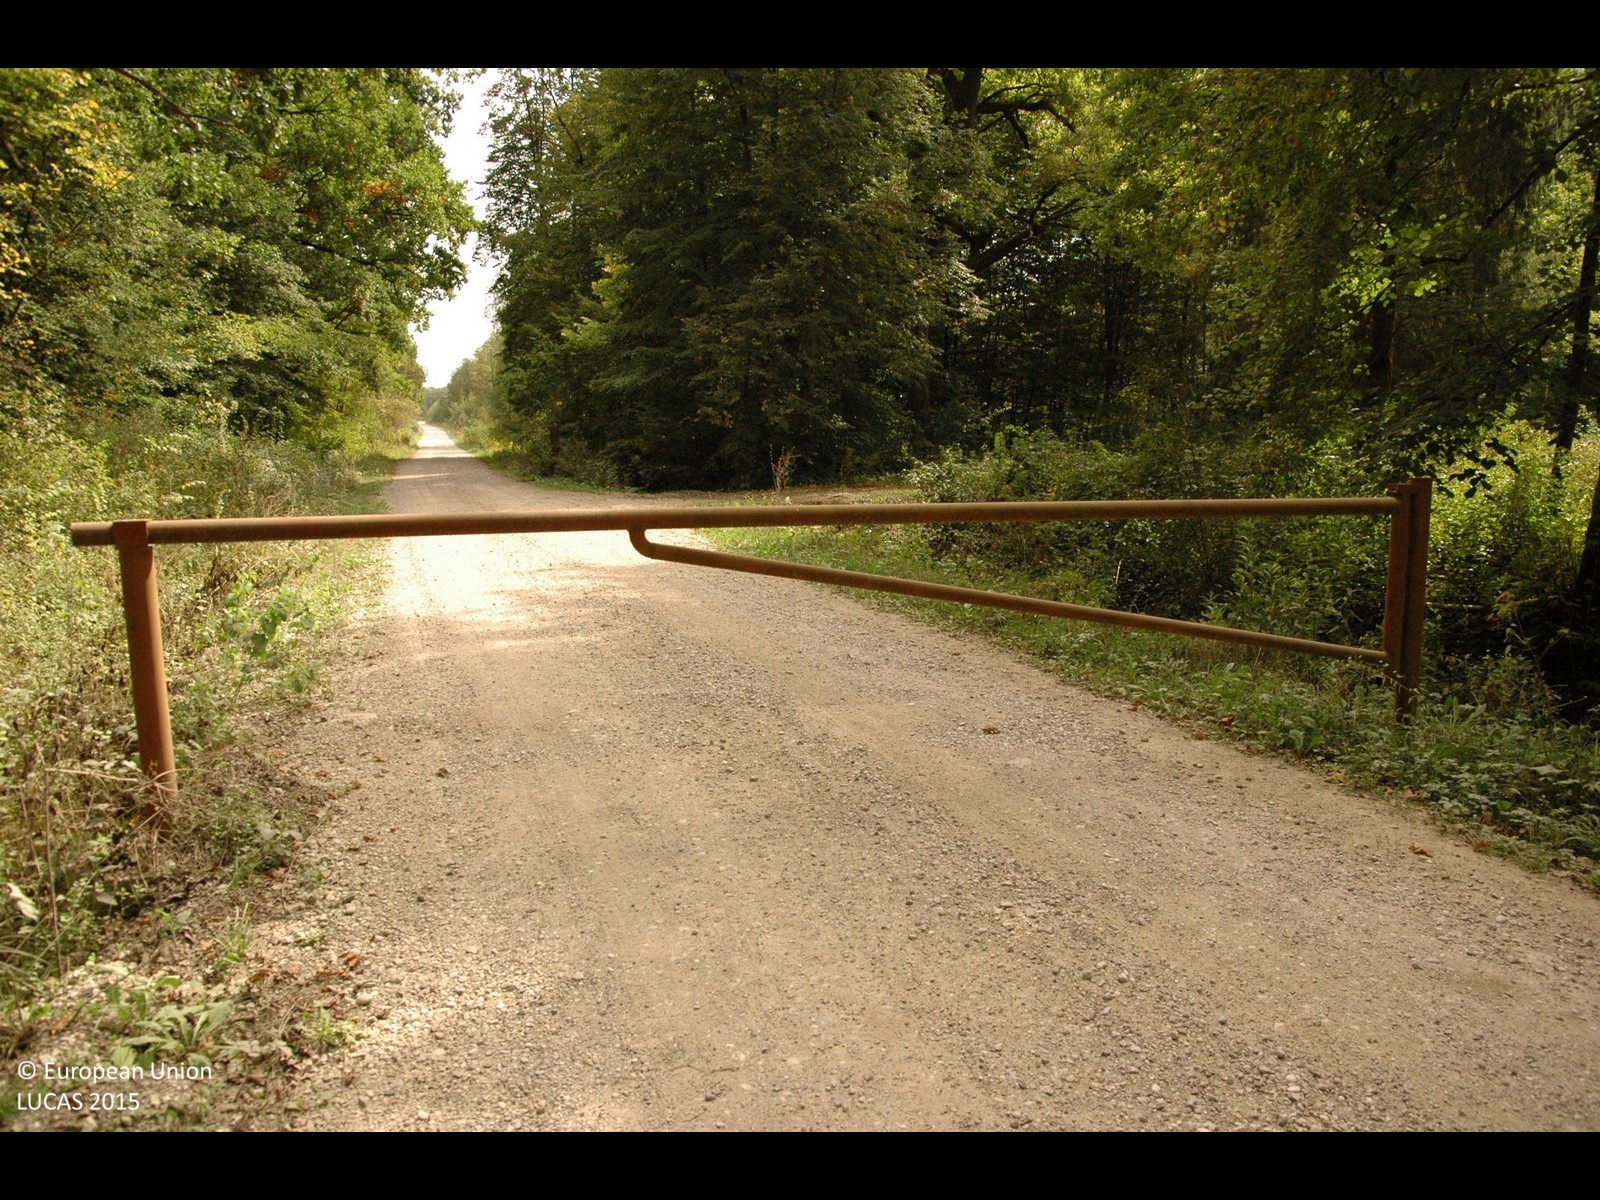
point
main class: Woodland
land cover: Broadleaved woodland
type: mesophytic deciduous forest
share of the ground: > 75 %
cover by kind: broadleaved forest trees 100 %
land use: Forestry
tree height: > 5 m
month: September
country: HR
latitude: 45.6088
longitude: 16.2424
